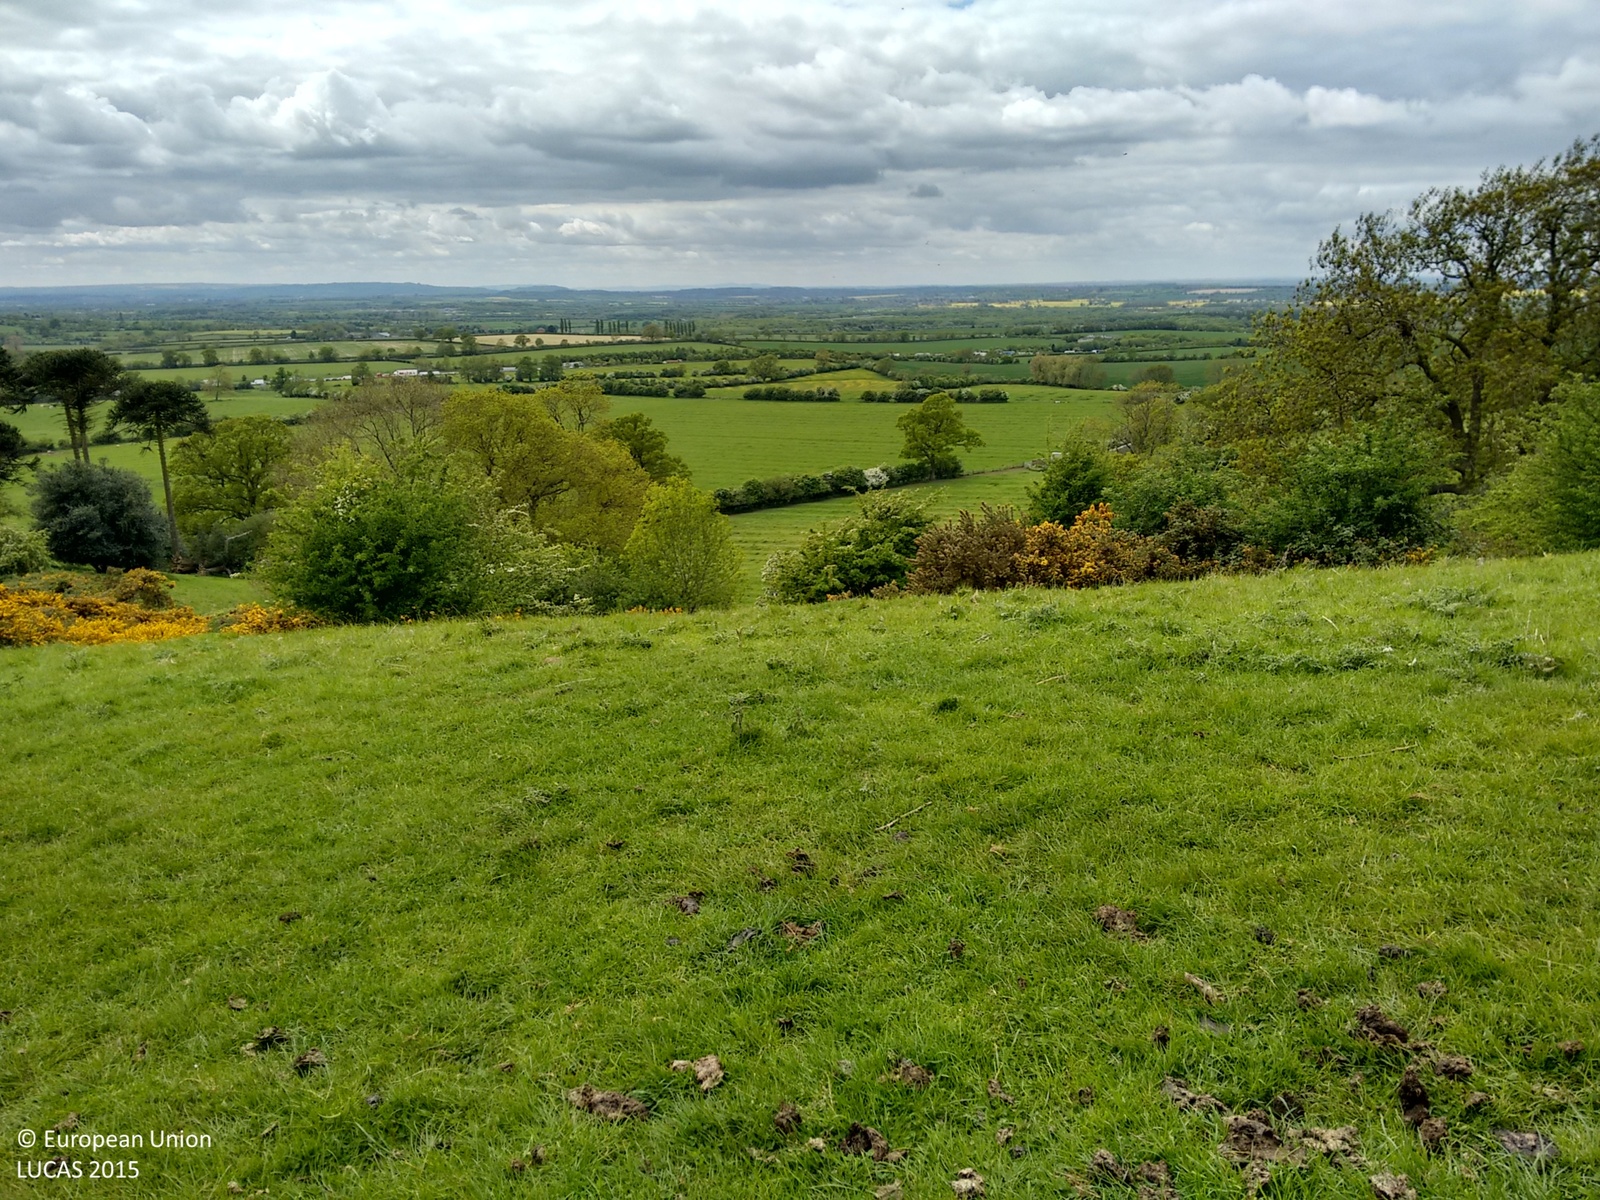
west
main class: Grassland
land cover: Grassland without tree/shrub cover
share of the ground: > 75 %
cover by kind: herbaceous plants 100 %
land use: Agriculture (excluding fallow land and kitchen gardens)
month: May
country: GB
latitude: 52.1526
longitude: -1.4061
